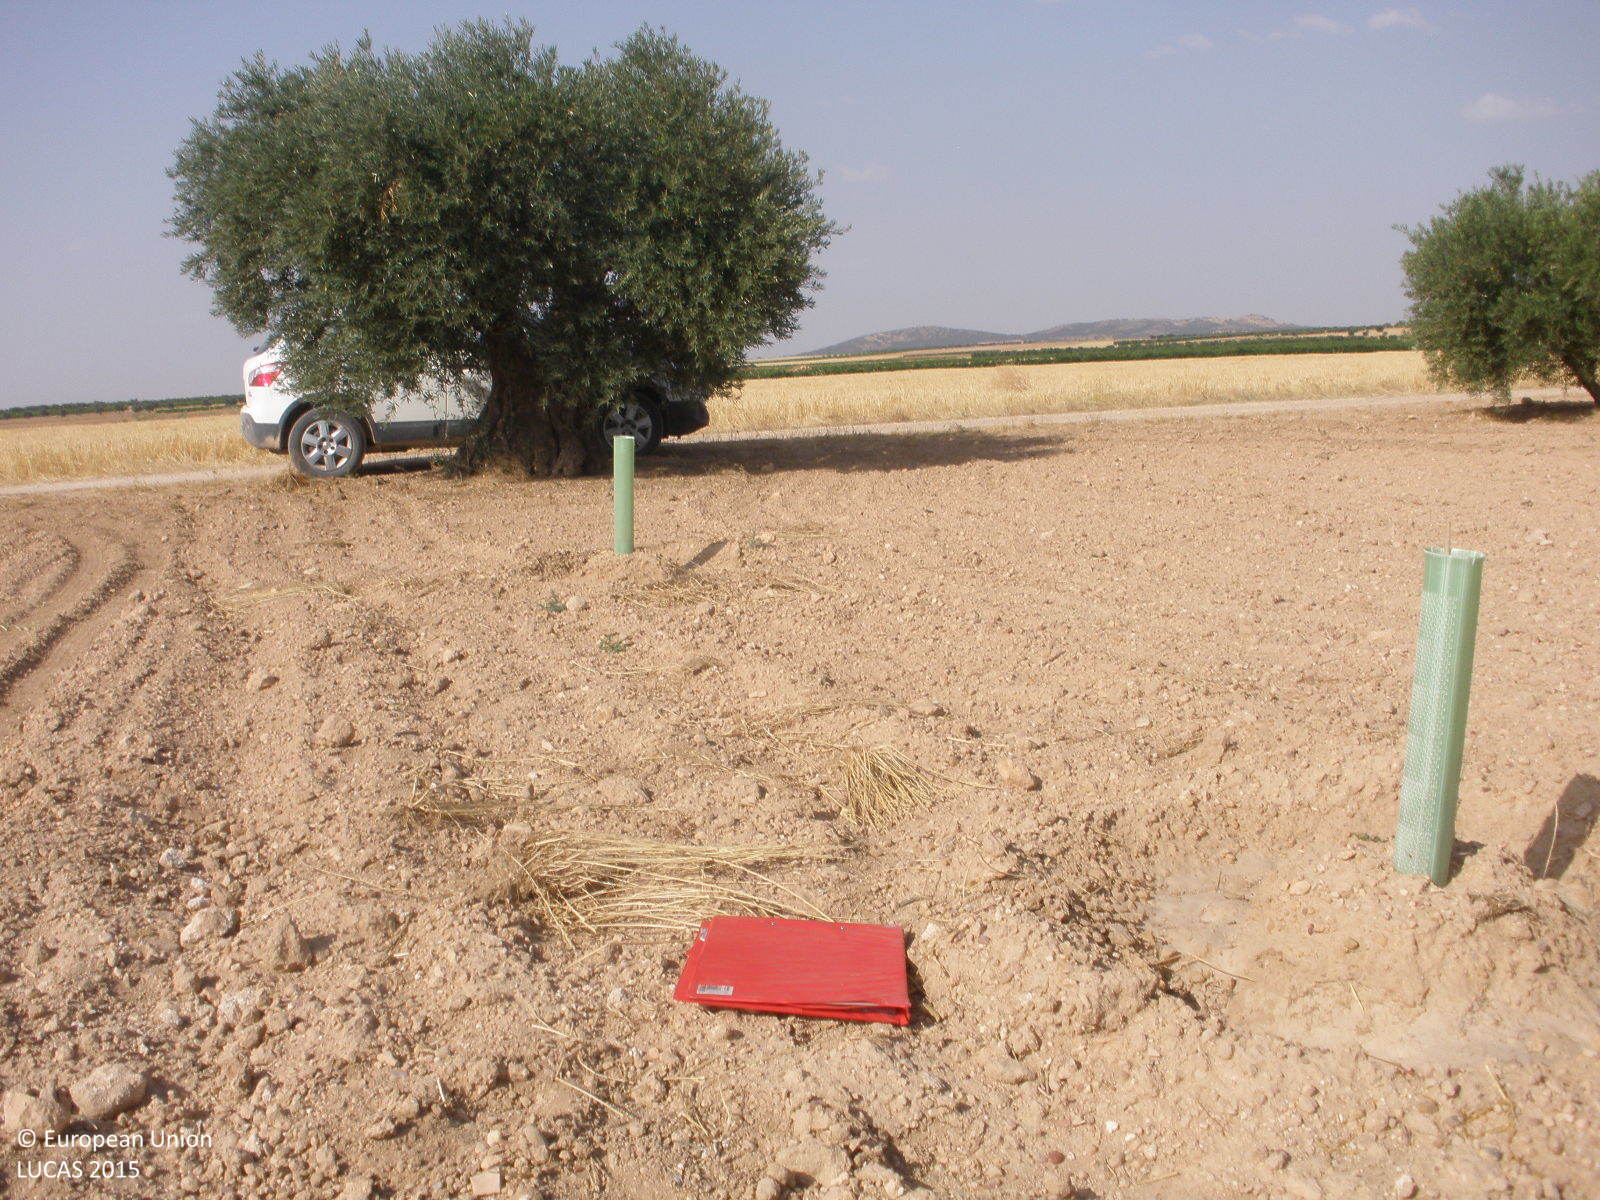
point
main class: Cropland
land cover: Nuts trees
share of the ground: < 10 %
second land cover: Other bare soil
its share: > 75 %
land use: Agriculture (excluding fallow land and kitchen gardens)
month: July
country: ES
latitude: 39.7074
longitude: -3.2846
